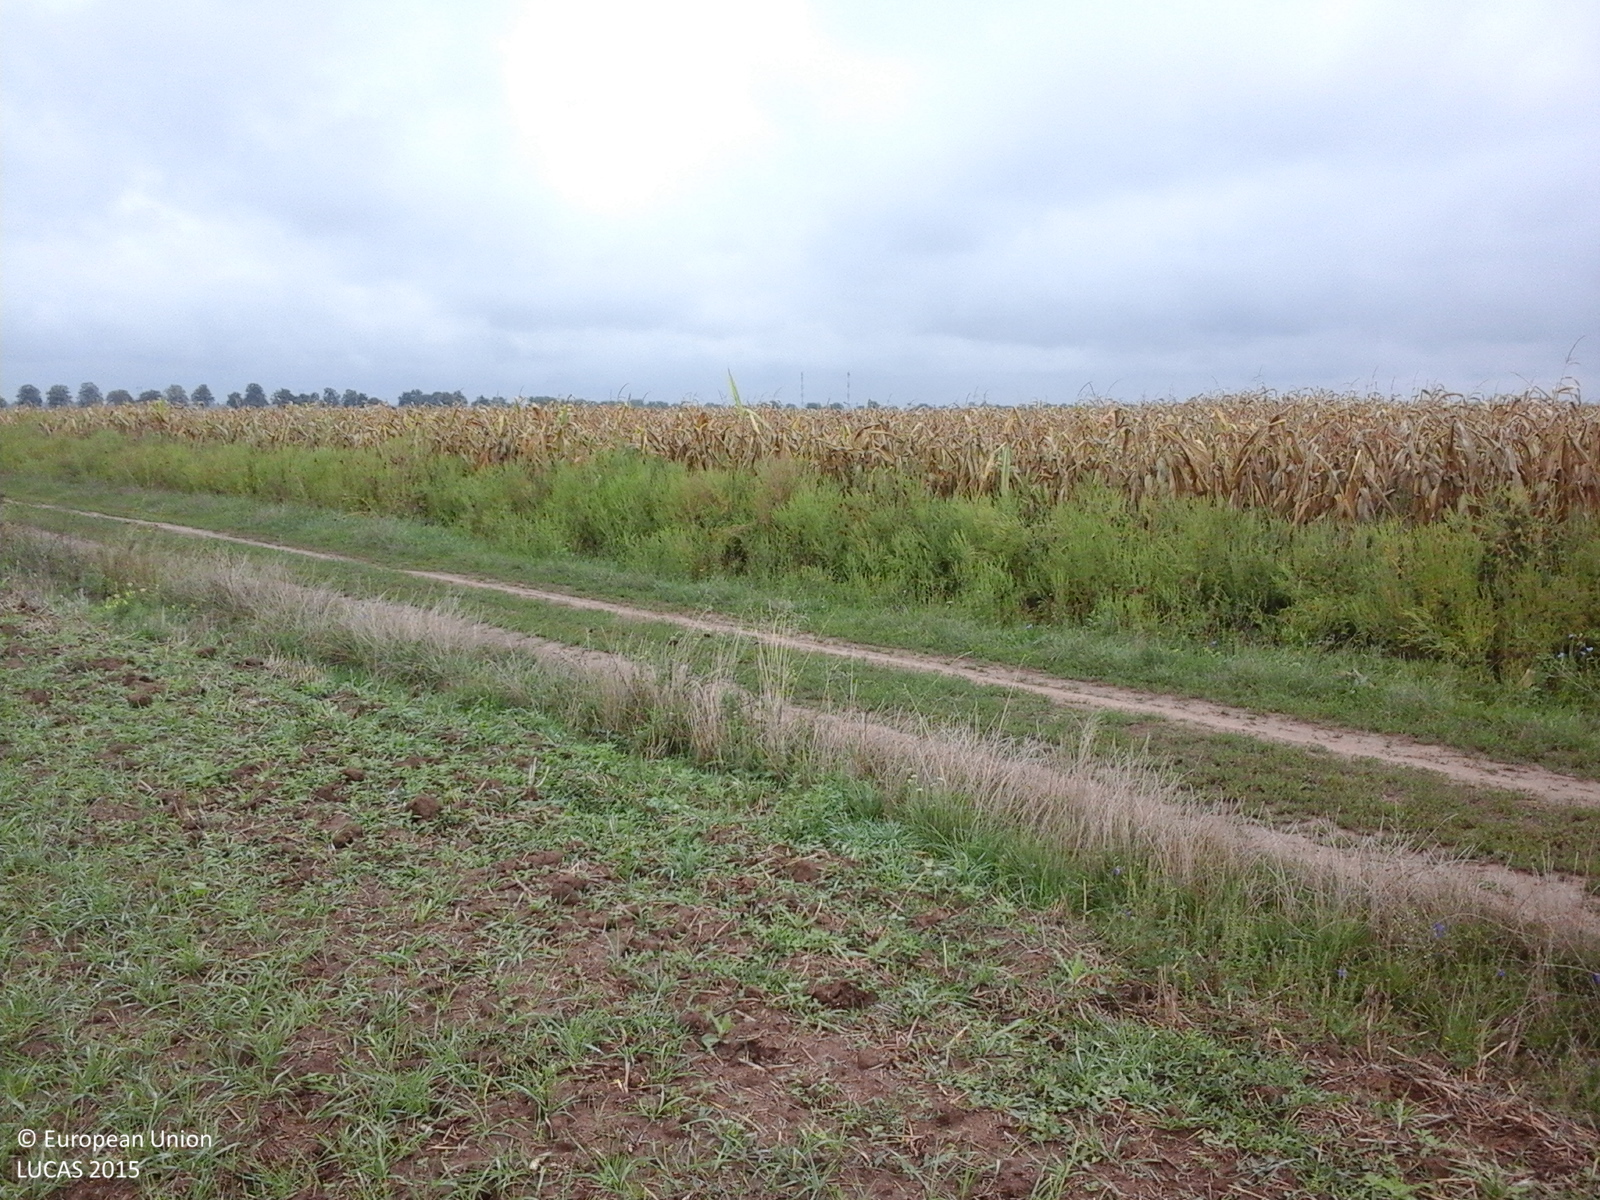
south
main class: Cropland
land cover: Durum wheat
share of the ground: 50 - 75 %
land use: Agriculture (excluding fallow land and kitchen gardens)
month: September
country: RO
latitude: 46.9504
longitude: 21.8035
